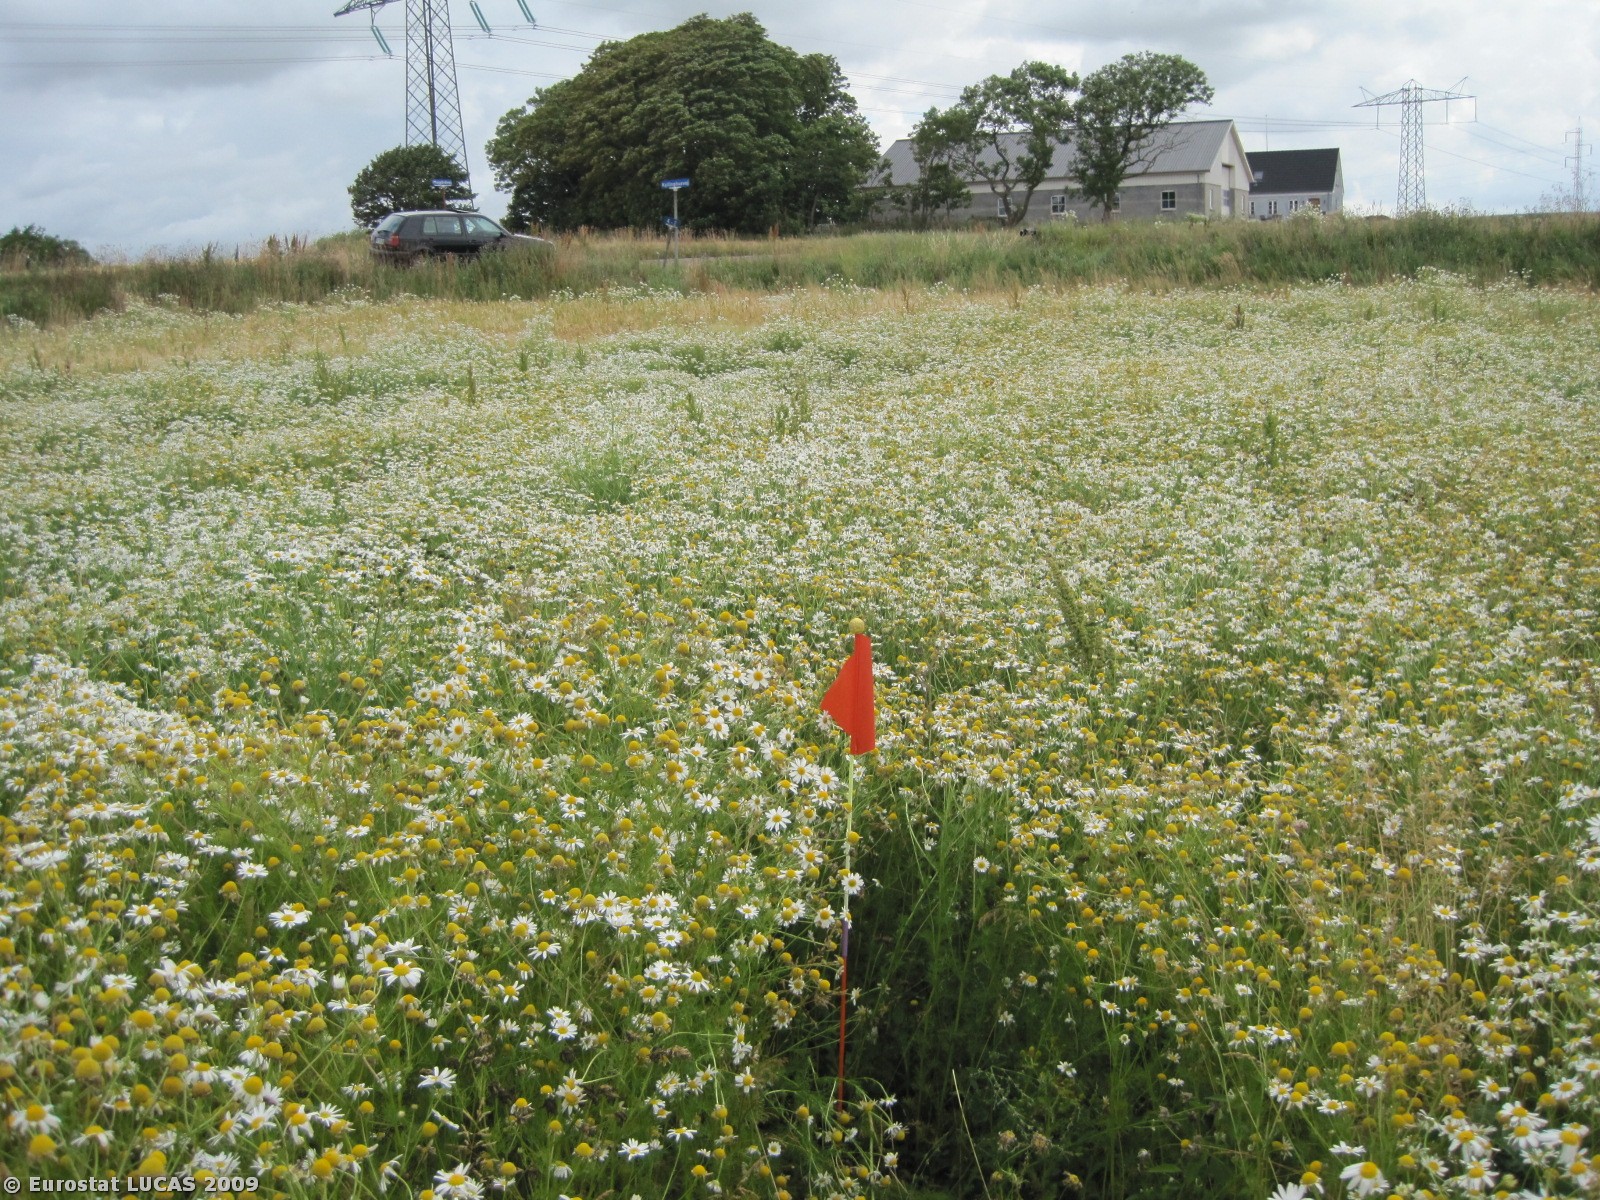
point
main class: Grassland
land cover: Grassland without tree/shrub cover
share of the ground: > 75 %
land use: Unused
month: July
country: DK
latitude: 56.3971
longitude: 8.7216
